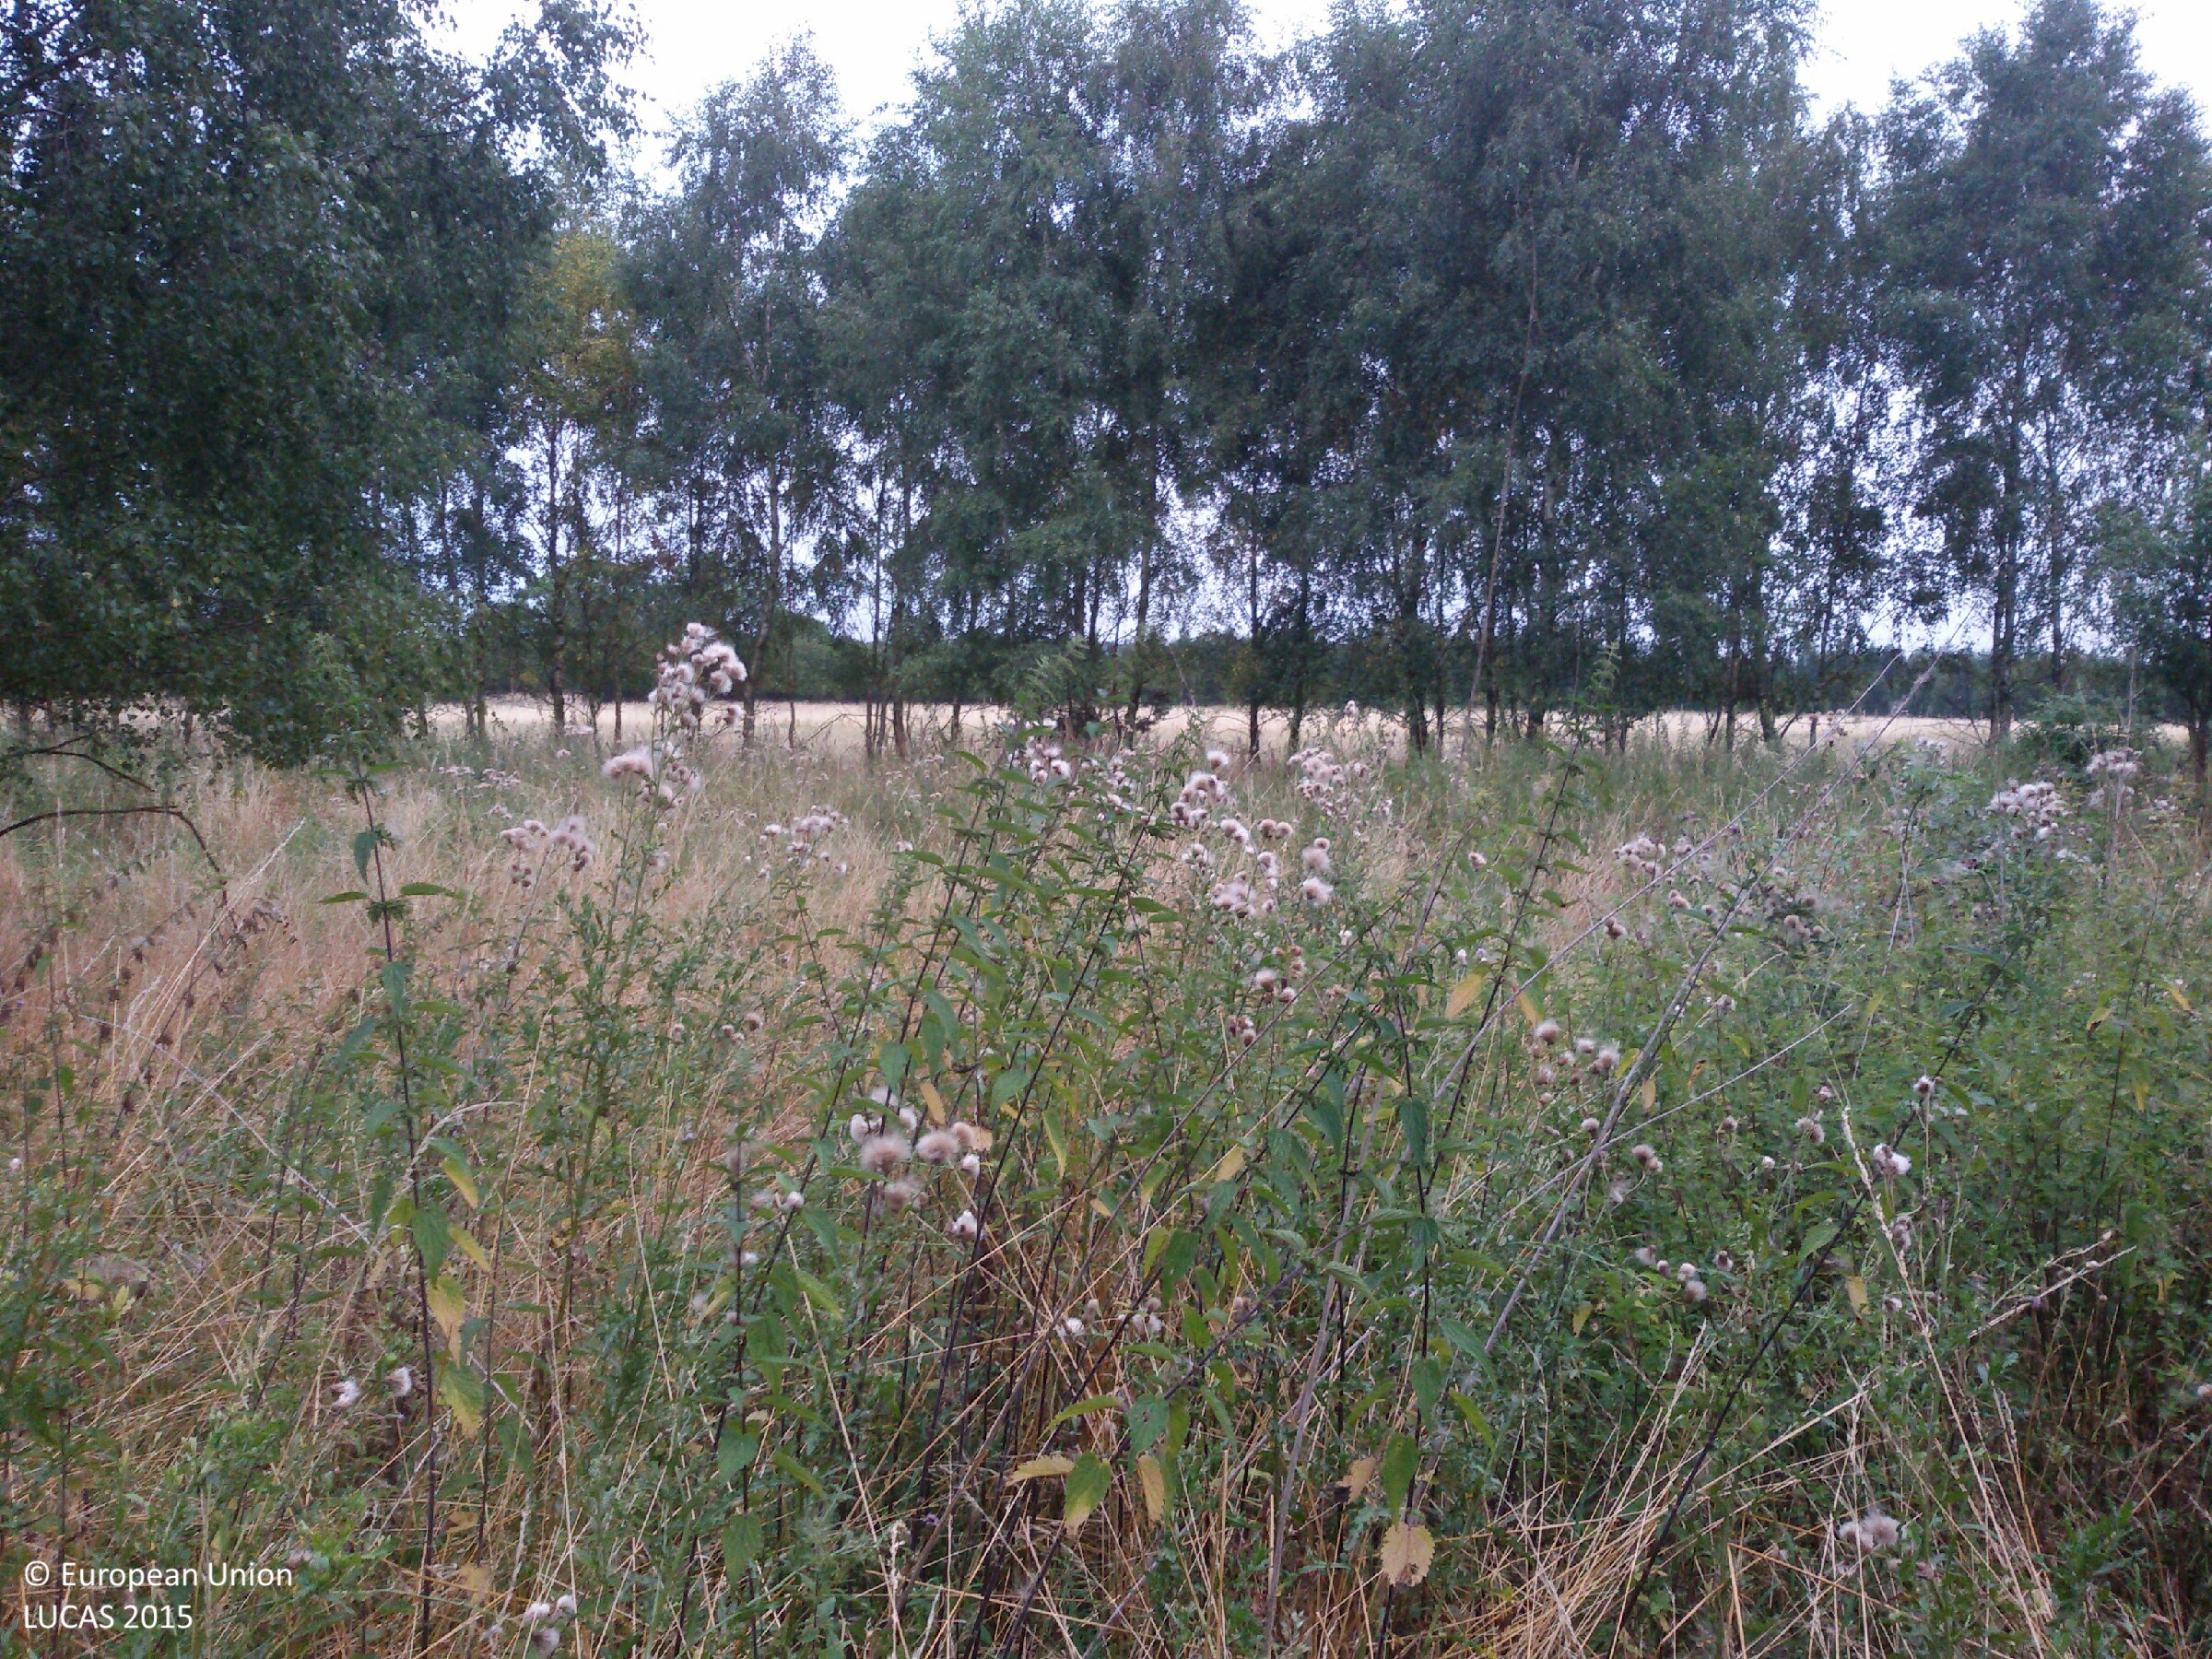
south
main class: Woodland
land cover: Broadleaved woodland
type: mesophytic deciduous forest
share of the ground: 25 - 50 %
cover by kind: herbaceous plants 55 %, broadleaved forest trees 30 %, shrubs 10 %, coniferous forest trees 5 %
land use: Semi-natural and natural areas not in use
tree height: > 5 m
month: August
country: PL
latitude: 52.9960
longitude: 14.4561
